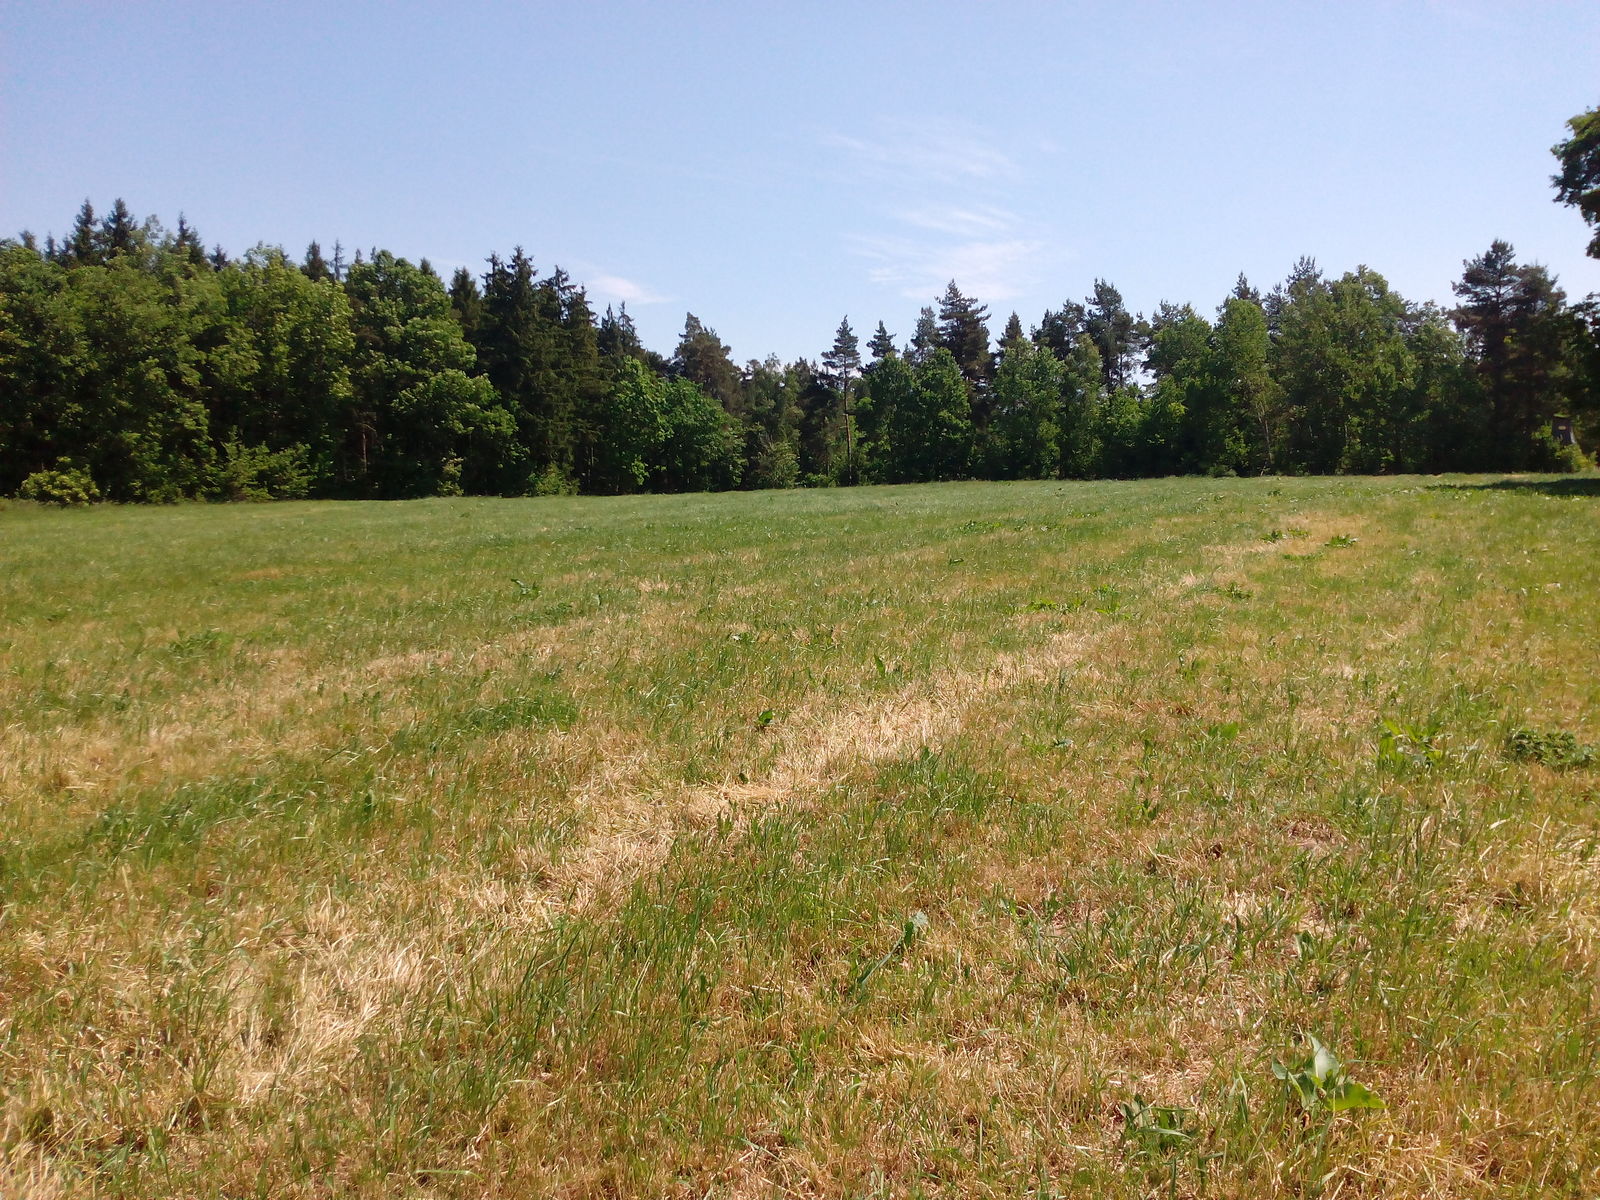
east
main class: Grassland
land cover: Grassland without tree/shrub cover
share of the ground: > 75 %
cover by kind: herbaceous plants 100 %
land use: Agriculture (excluding fallow land and kitchen gardens)
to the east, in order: Grassland without tree/shrub cover; Other mixed woodland; Tracks; Other mixed woodland
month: June
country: DE
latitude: 50.8297
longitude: 10.6387
